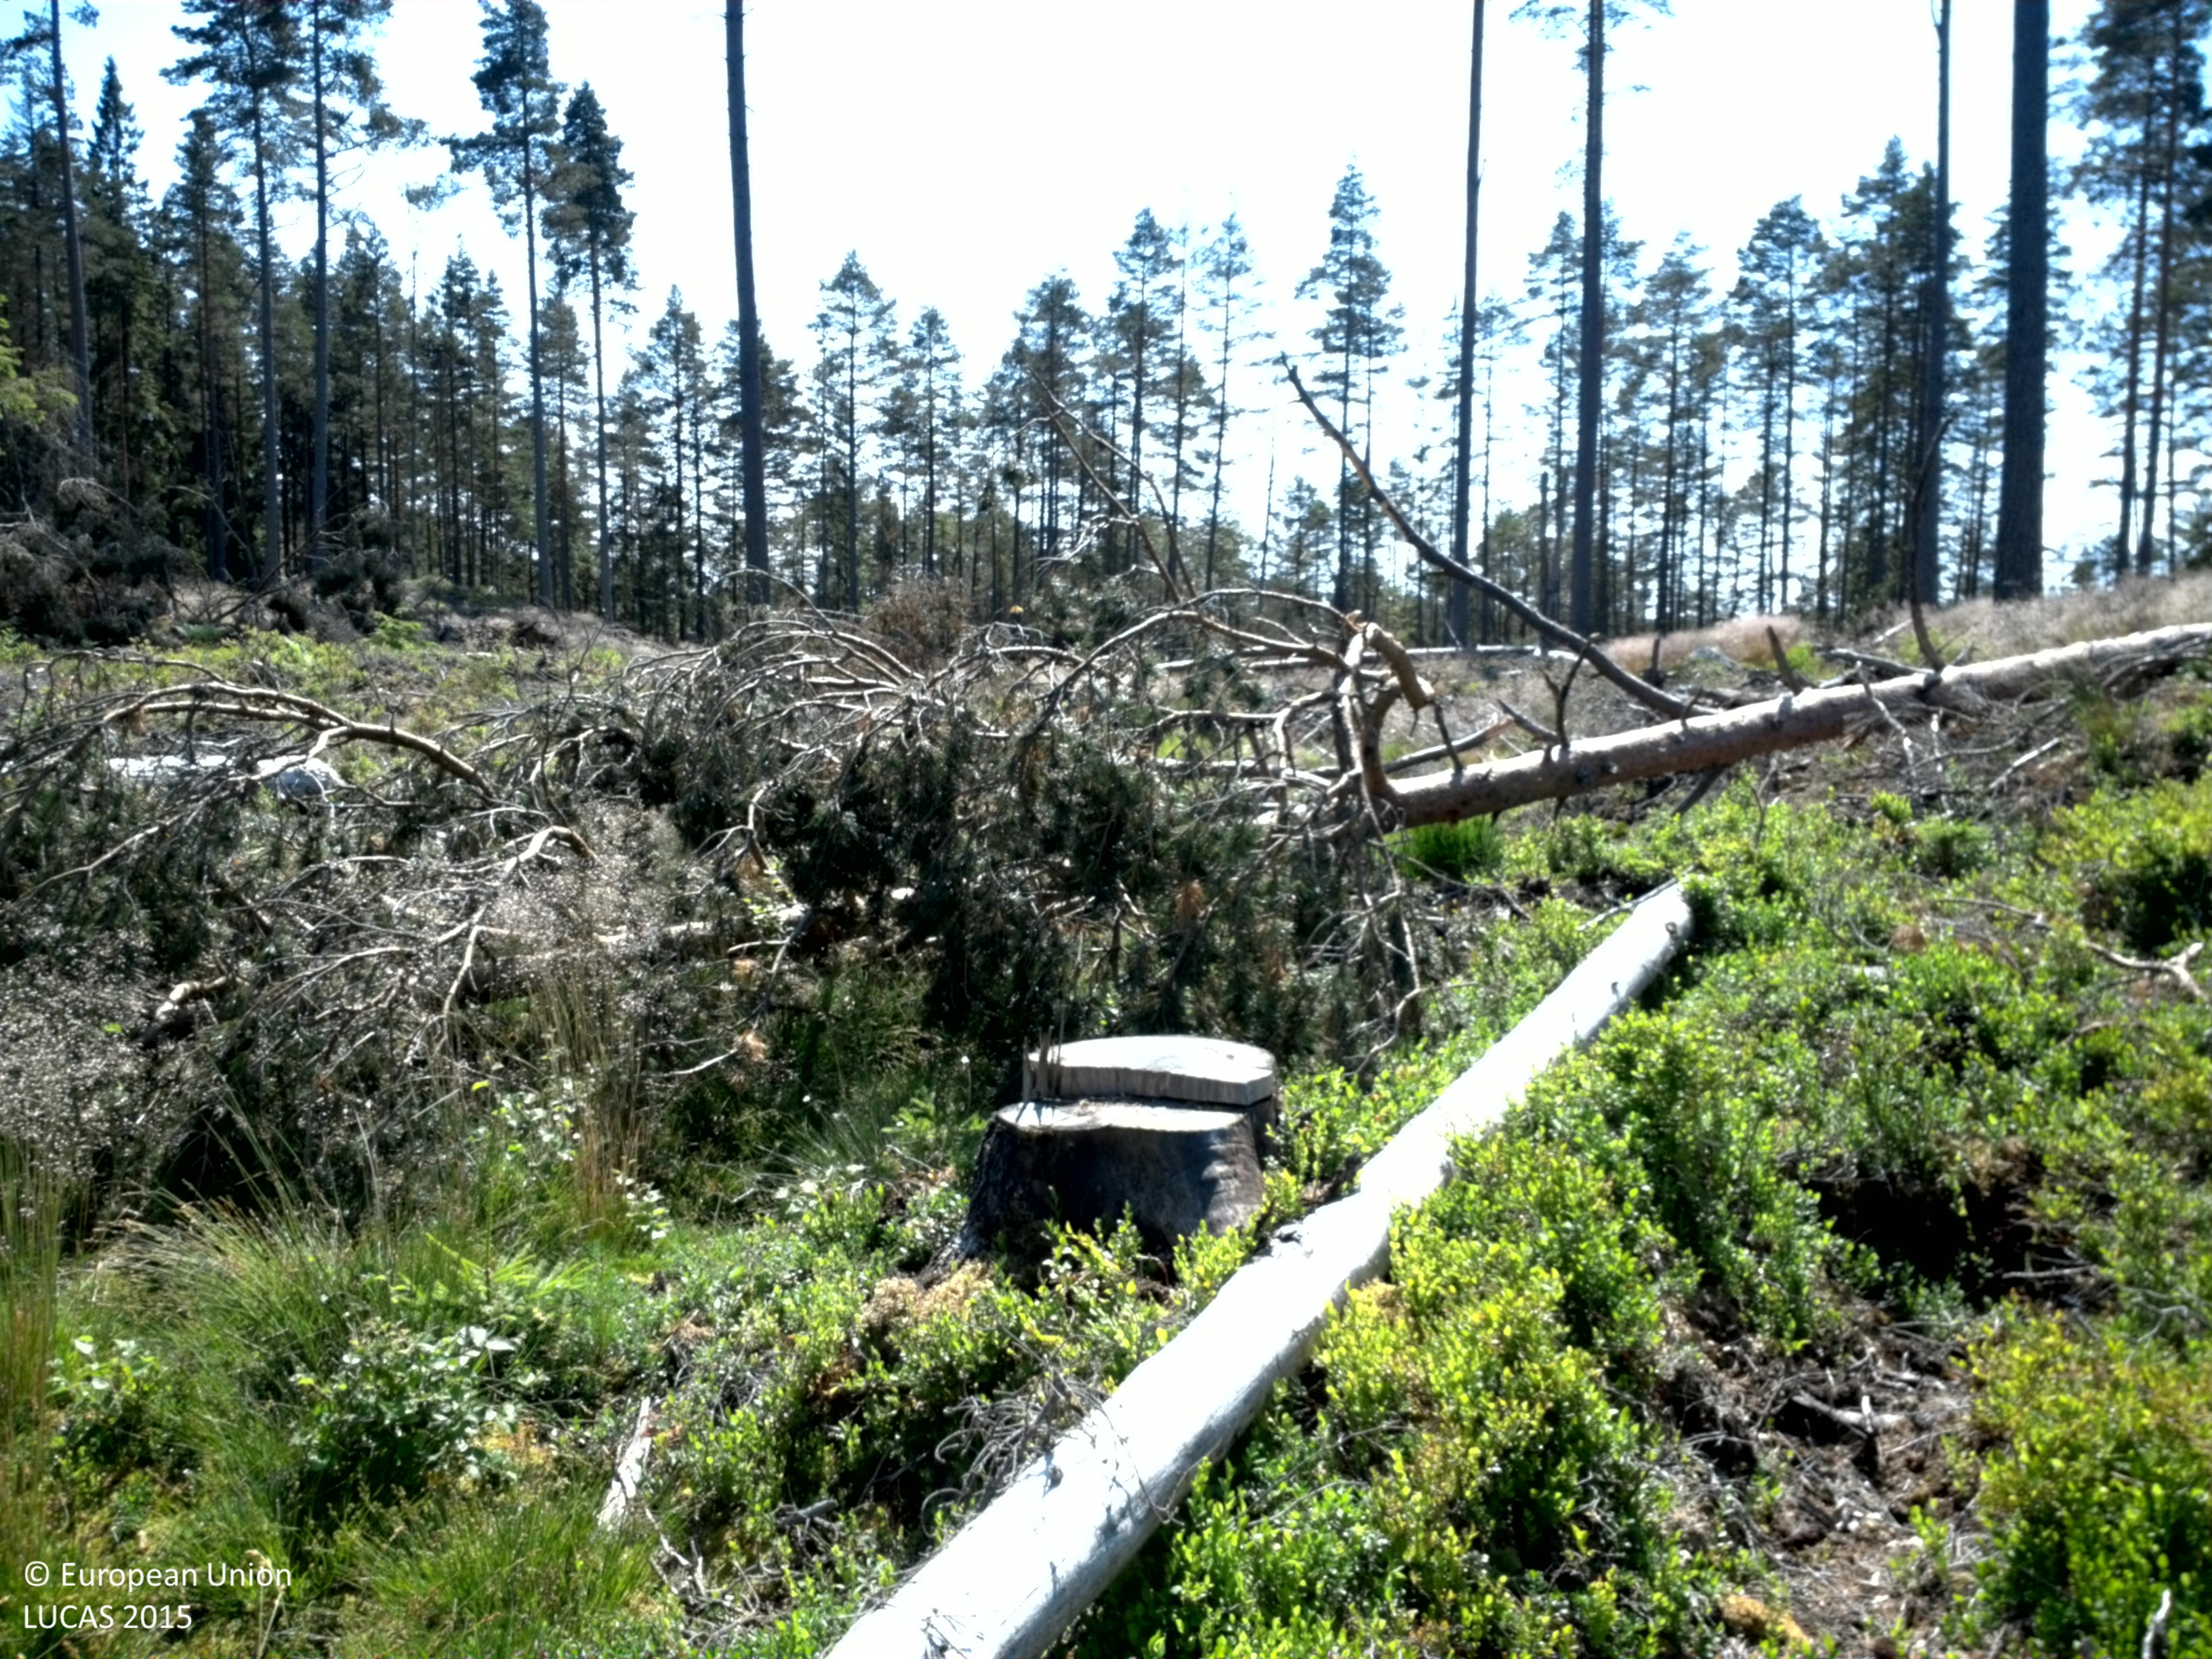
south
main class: Woodland
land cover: Pine dominated coniferous woodland
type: boreal forest
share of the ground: 10 - 25 %
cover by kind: herbaceous plants 60 %, lichens and mosses 30 %, coniferous forest trees 10 %
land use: Forestry
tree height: > 5 m
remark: Clear cut
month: July
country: SE
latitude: 58.7712
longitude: 14.6100
